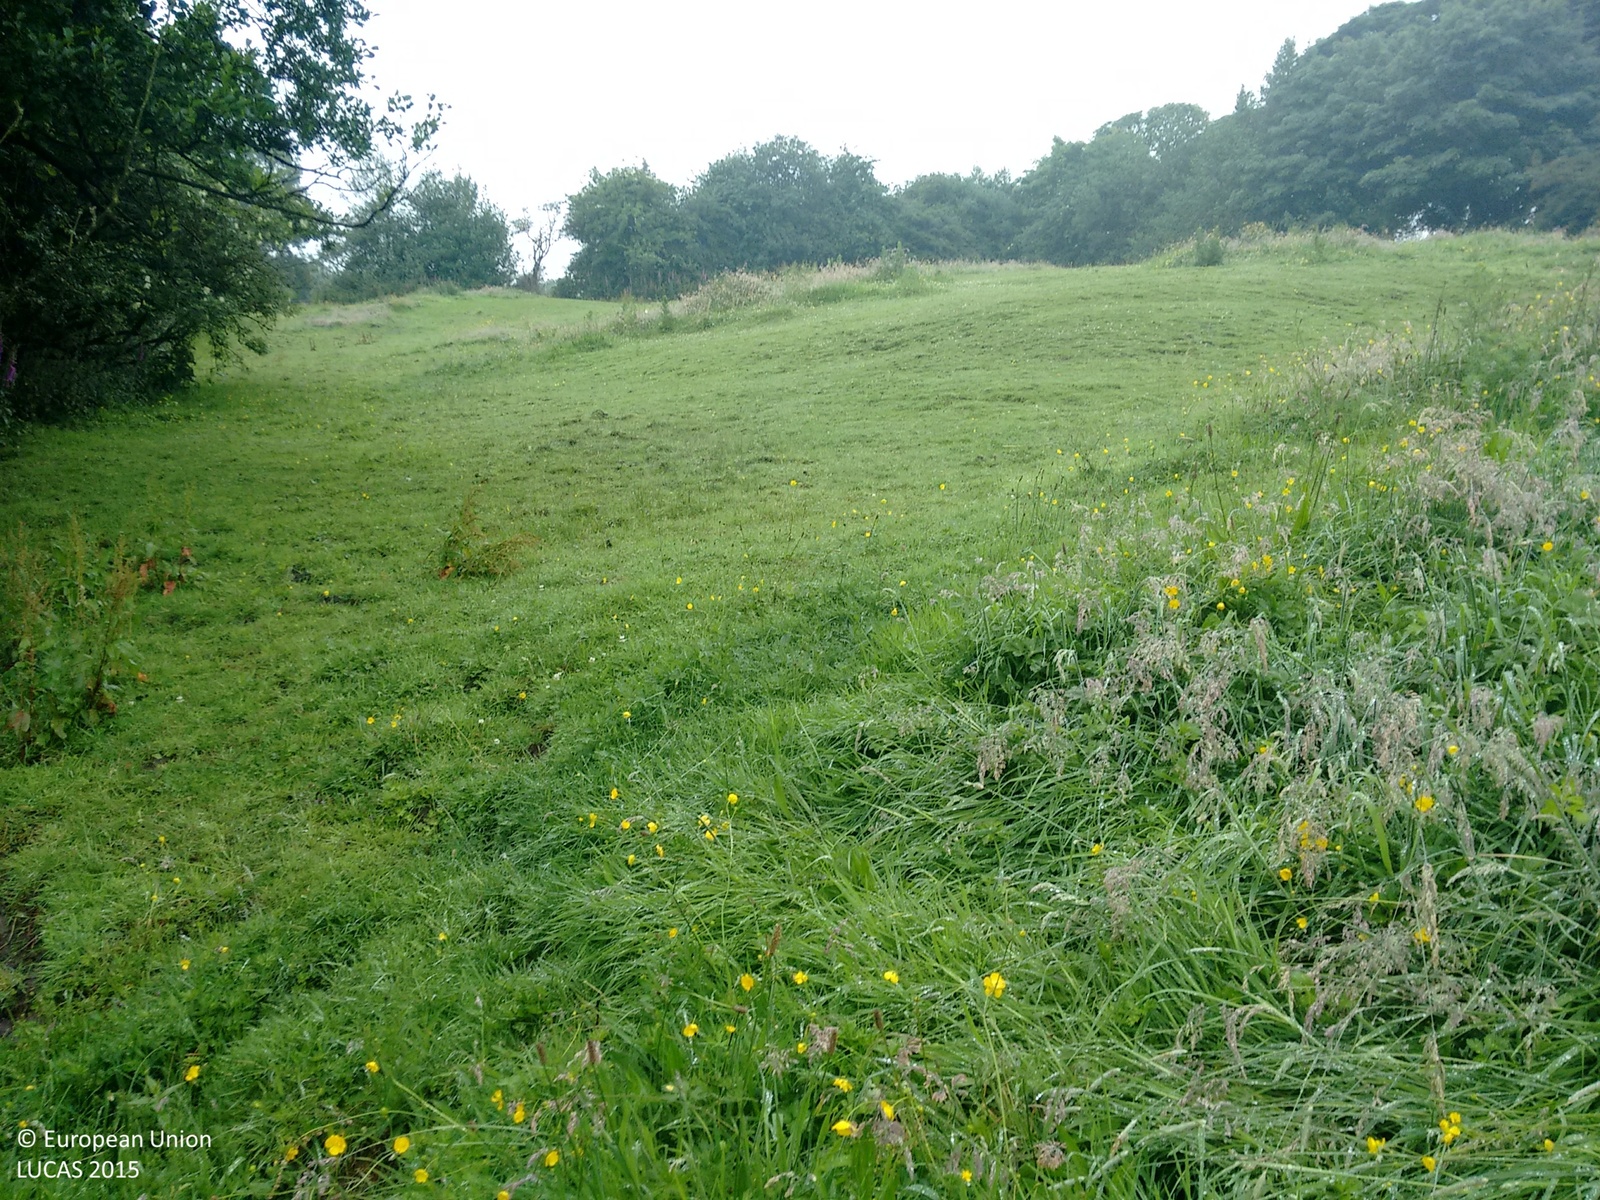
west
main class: Grassland
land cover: Grassland without tree/shrub cover
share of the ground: > 75 %
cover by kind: herbaceous plants 100 %
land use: Agriculture (excluding fallow land and kitchen gardens)
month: July
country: GB
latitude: 53.1447
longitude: -2.0338
